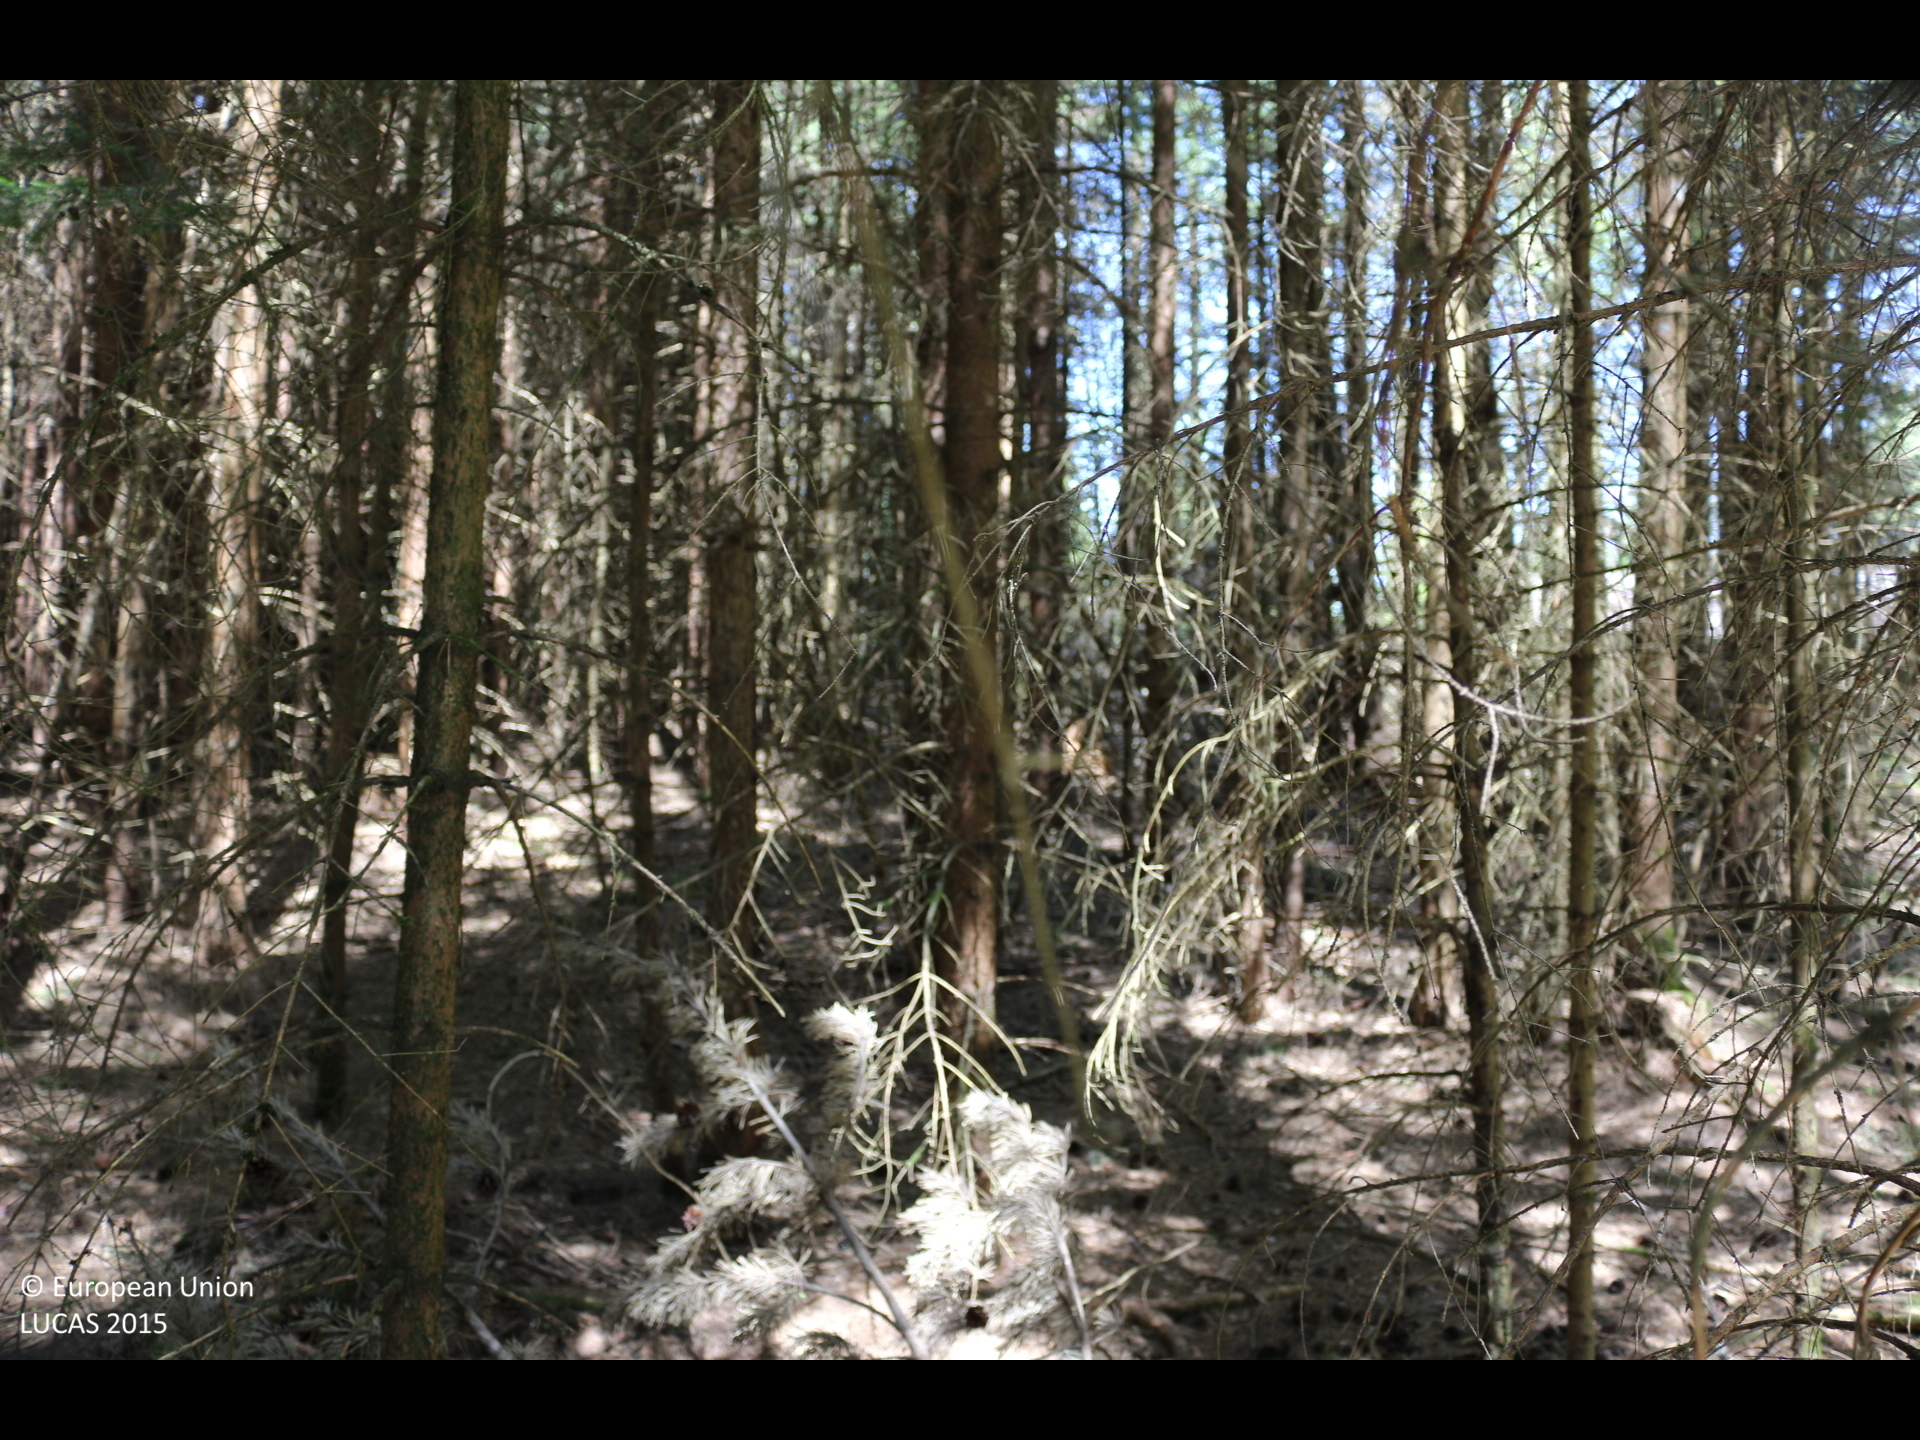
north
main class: Woodland
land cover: Spruce dominated coniferous woodland
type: alpine coniferous forest
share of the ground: > 75 %
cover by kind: coniferous forest trees 100 %
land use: Forestry
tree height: > 5 m
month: May
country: AT
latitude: 46.8065
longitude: 14.2828
